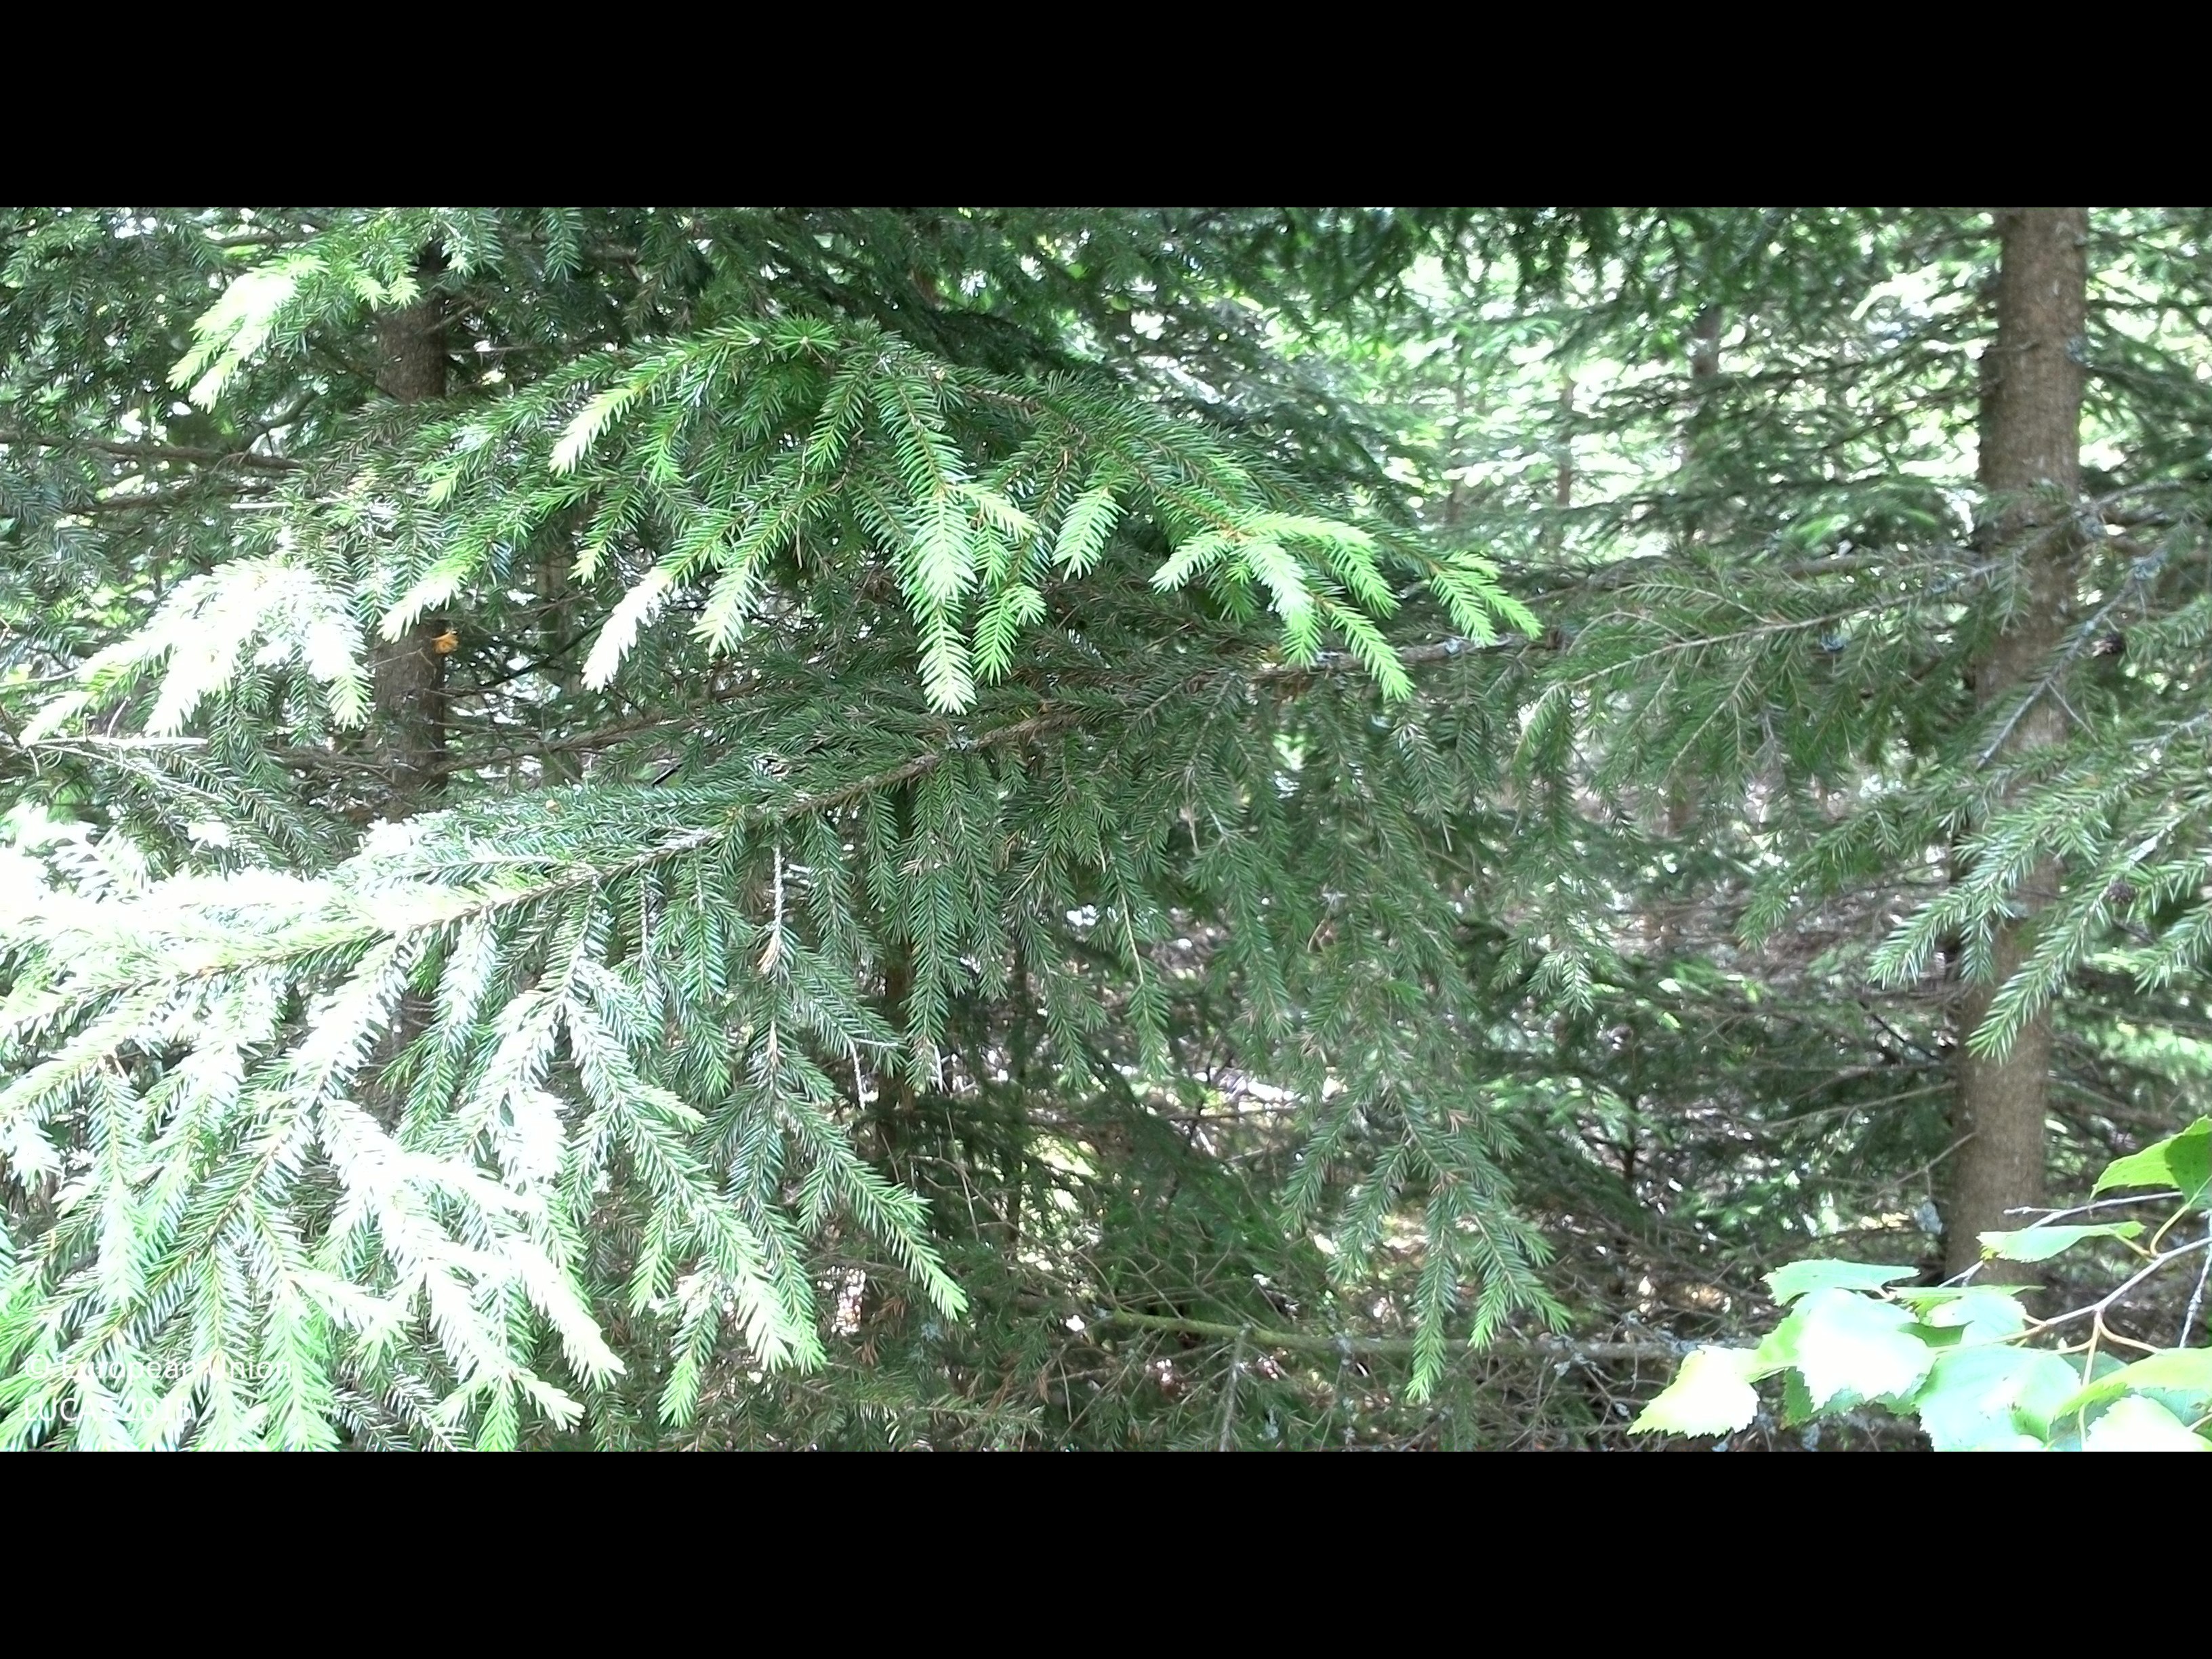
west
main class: Woodland
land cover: Spruce dominated coniferous woodland
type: boreal forest
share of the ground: > 75 %
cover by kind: coniferous forest trees 75 %, shrubs 10 %, broadleaved forest trees 5 %, herbaceous plants 5 %, lichens and mosses 5 %
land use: Forestry
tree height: > 5 m
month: July
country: SE
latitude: 56.3543
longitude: 15.1611
